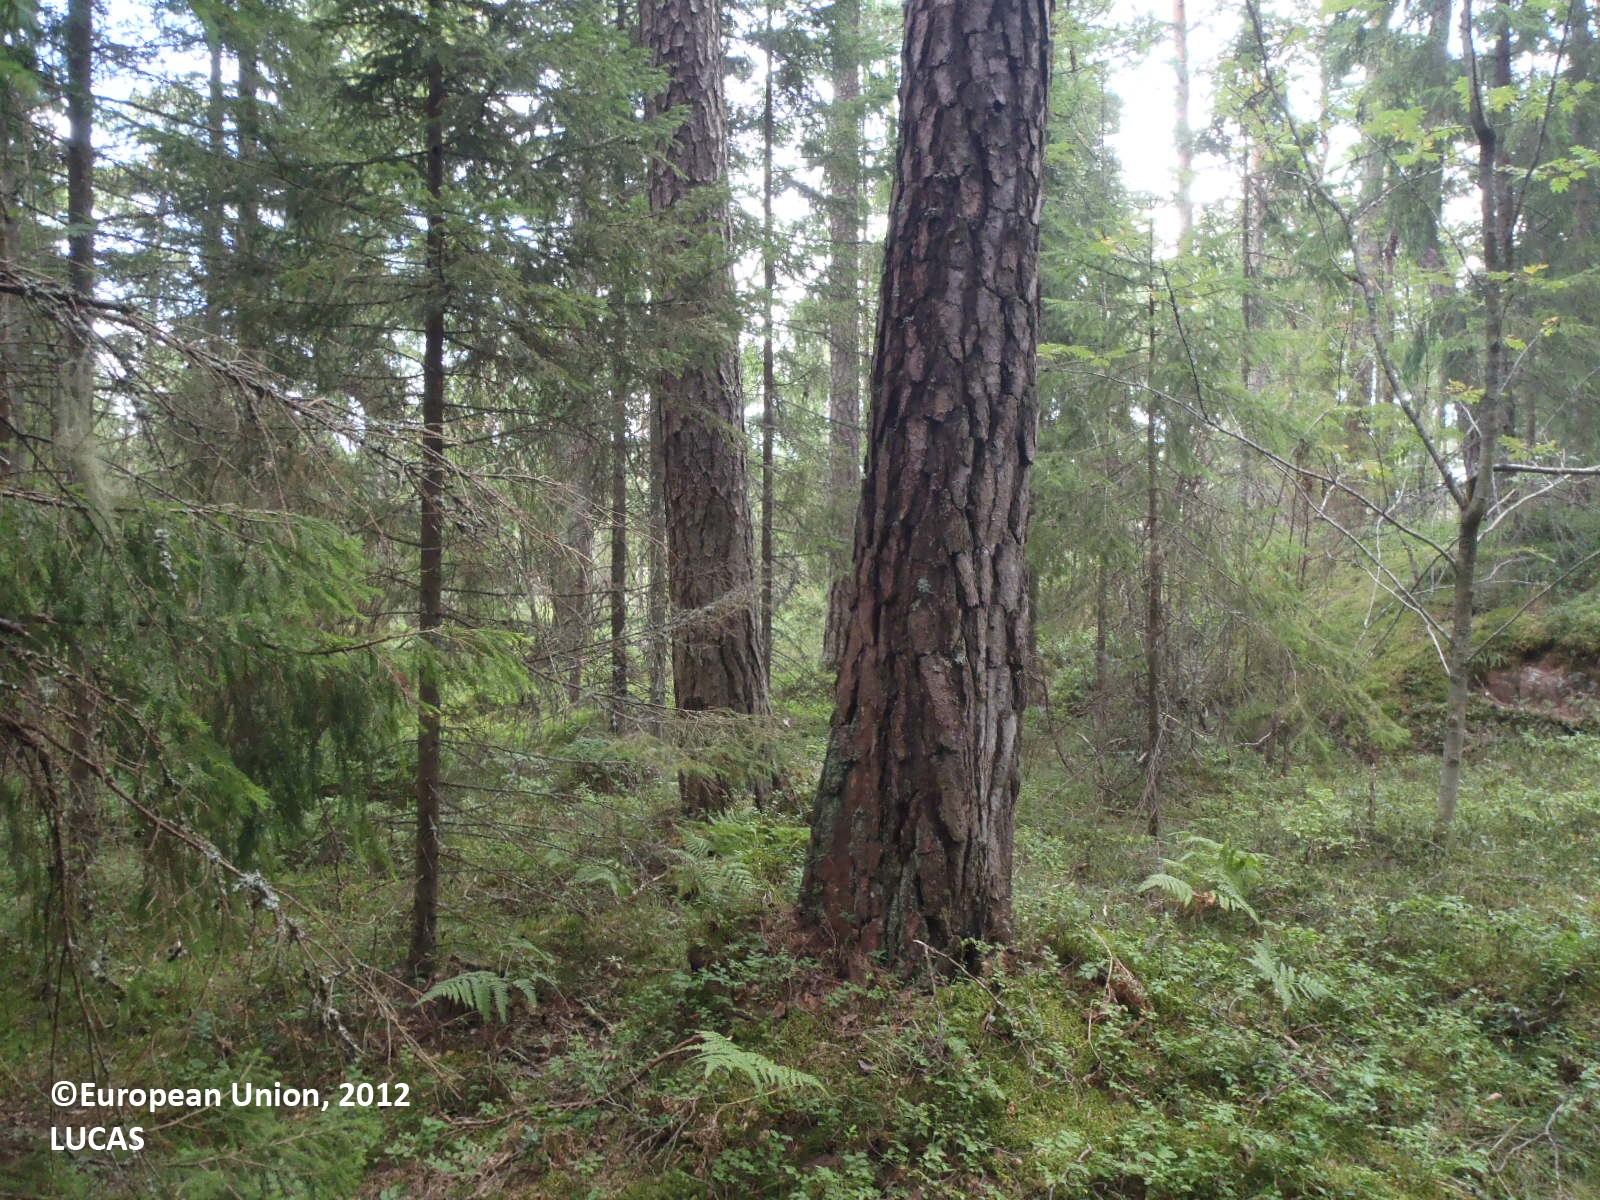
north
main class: Woodland
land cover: Pine dominated coniferous woodland
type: hemiboreal forest and nemoral coniferous forest and mixed broadleaved-coniferous forest
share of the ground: > 75 %
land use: Forestry
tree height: > 5 m
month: August
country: FI
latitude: 60.2631
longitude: 19.9648
